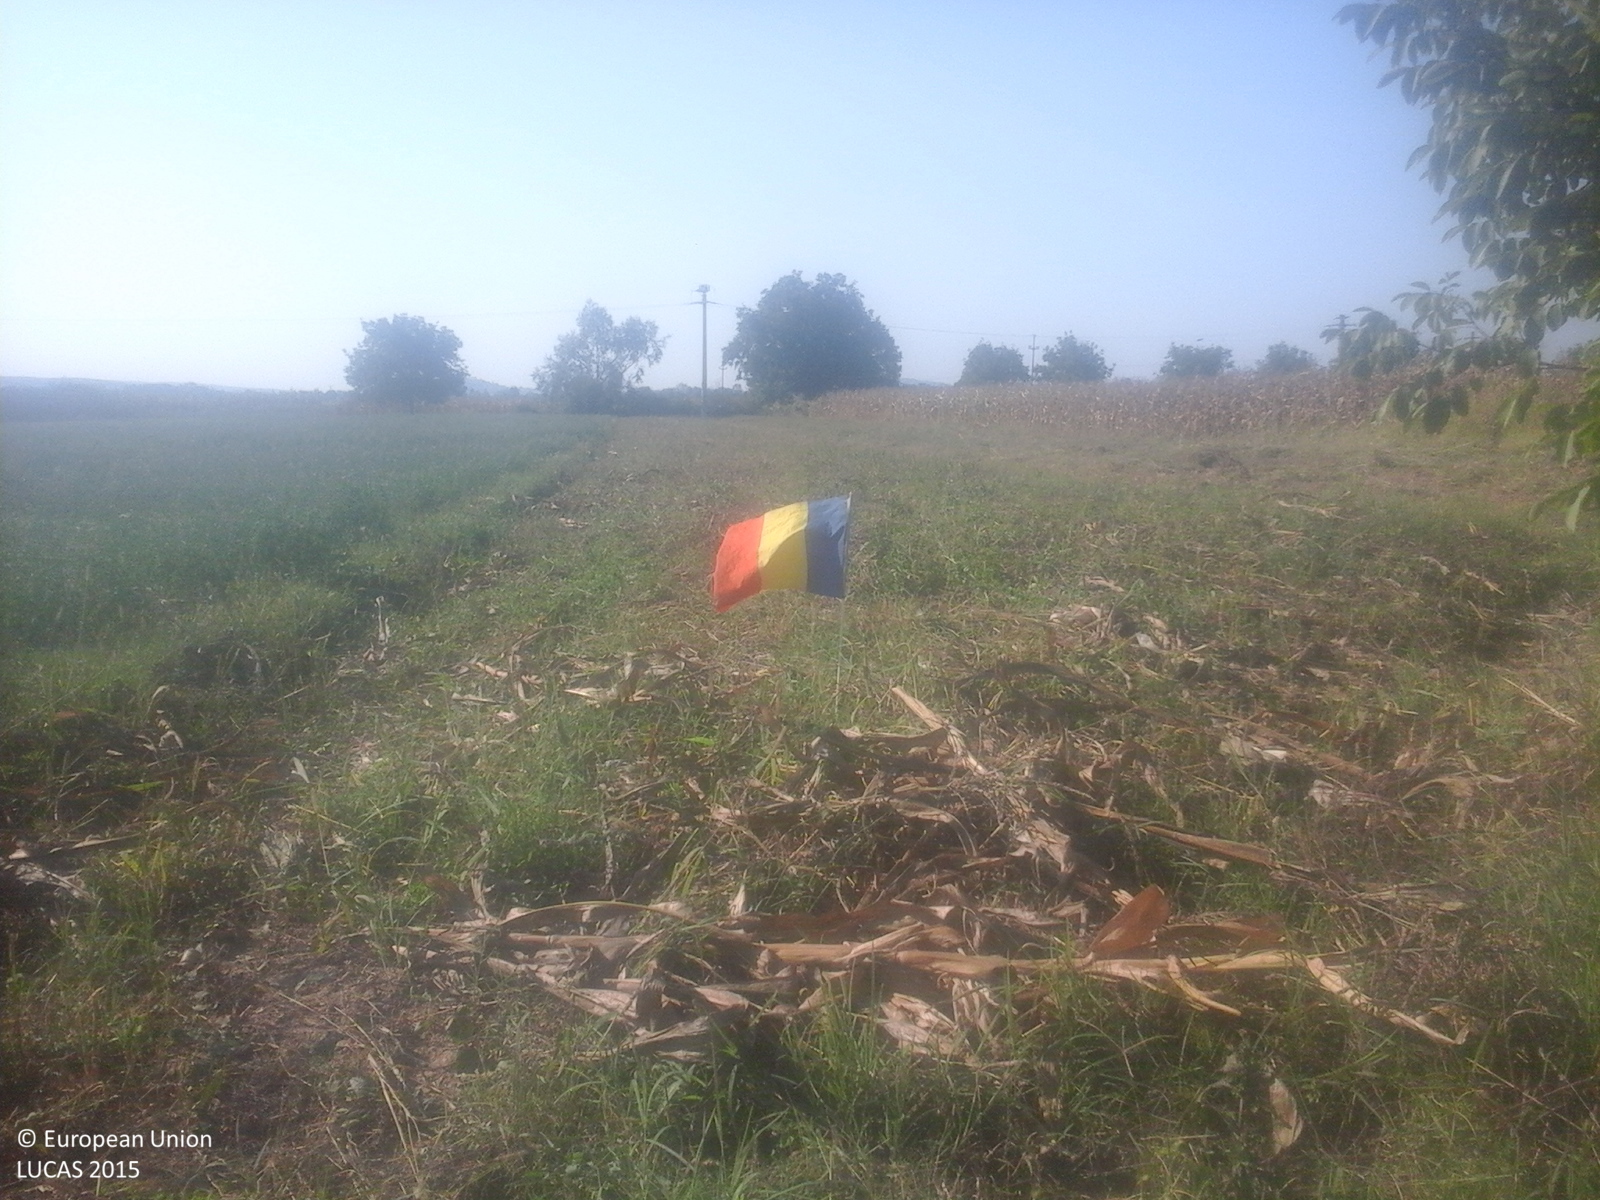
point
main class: Cropland
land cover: Potatoes
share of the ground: > 75 %
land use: Agriculture (excluding fallow land and kitchen gardens)
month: September
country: RO
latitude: 46.6526
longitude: 22.3459
